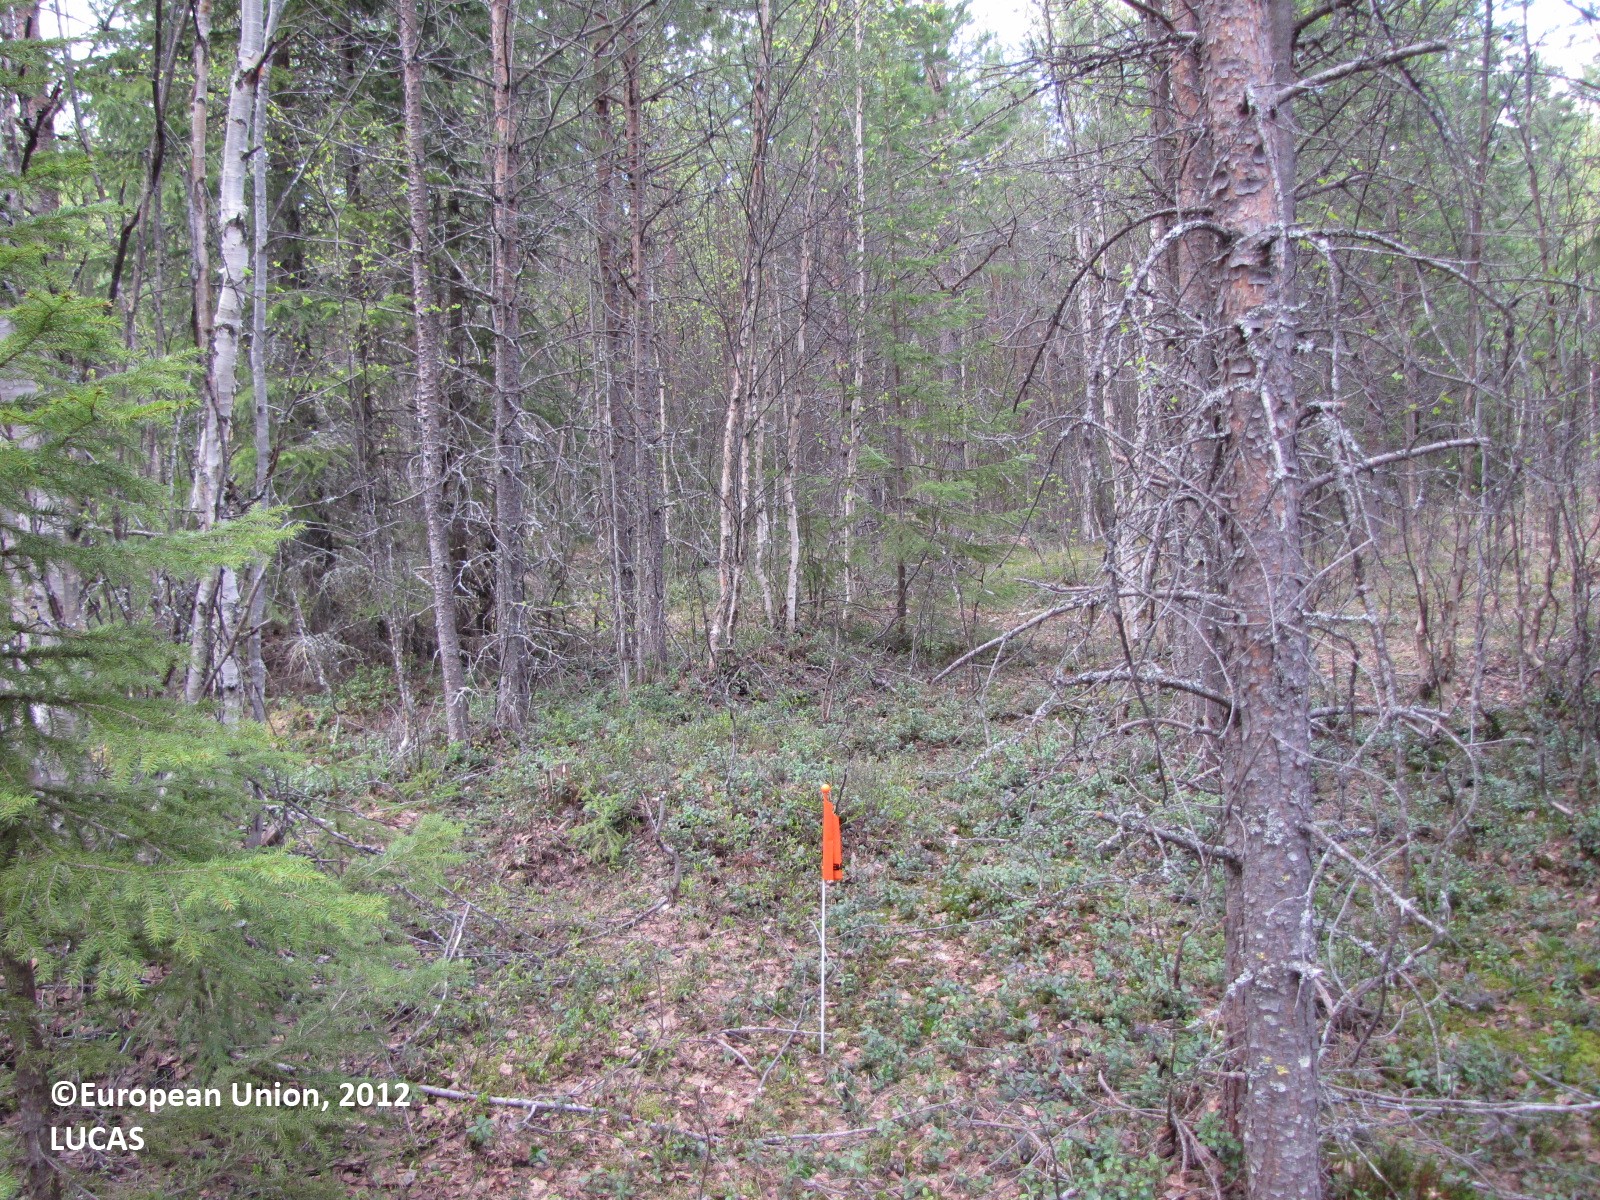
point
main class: Woodland
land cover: Other mixed woodland
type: boreal forest
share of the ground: > 75 %
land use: Forestry
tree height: > 5 m
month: May
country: FI
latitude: 65.7218
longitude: 24.6833
